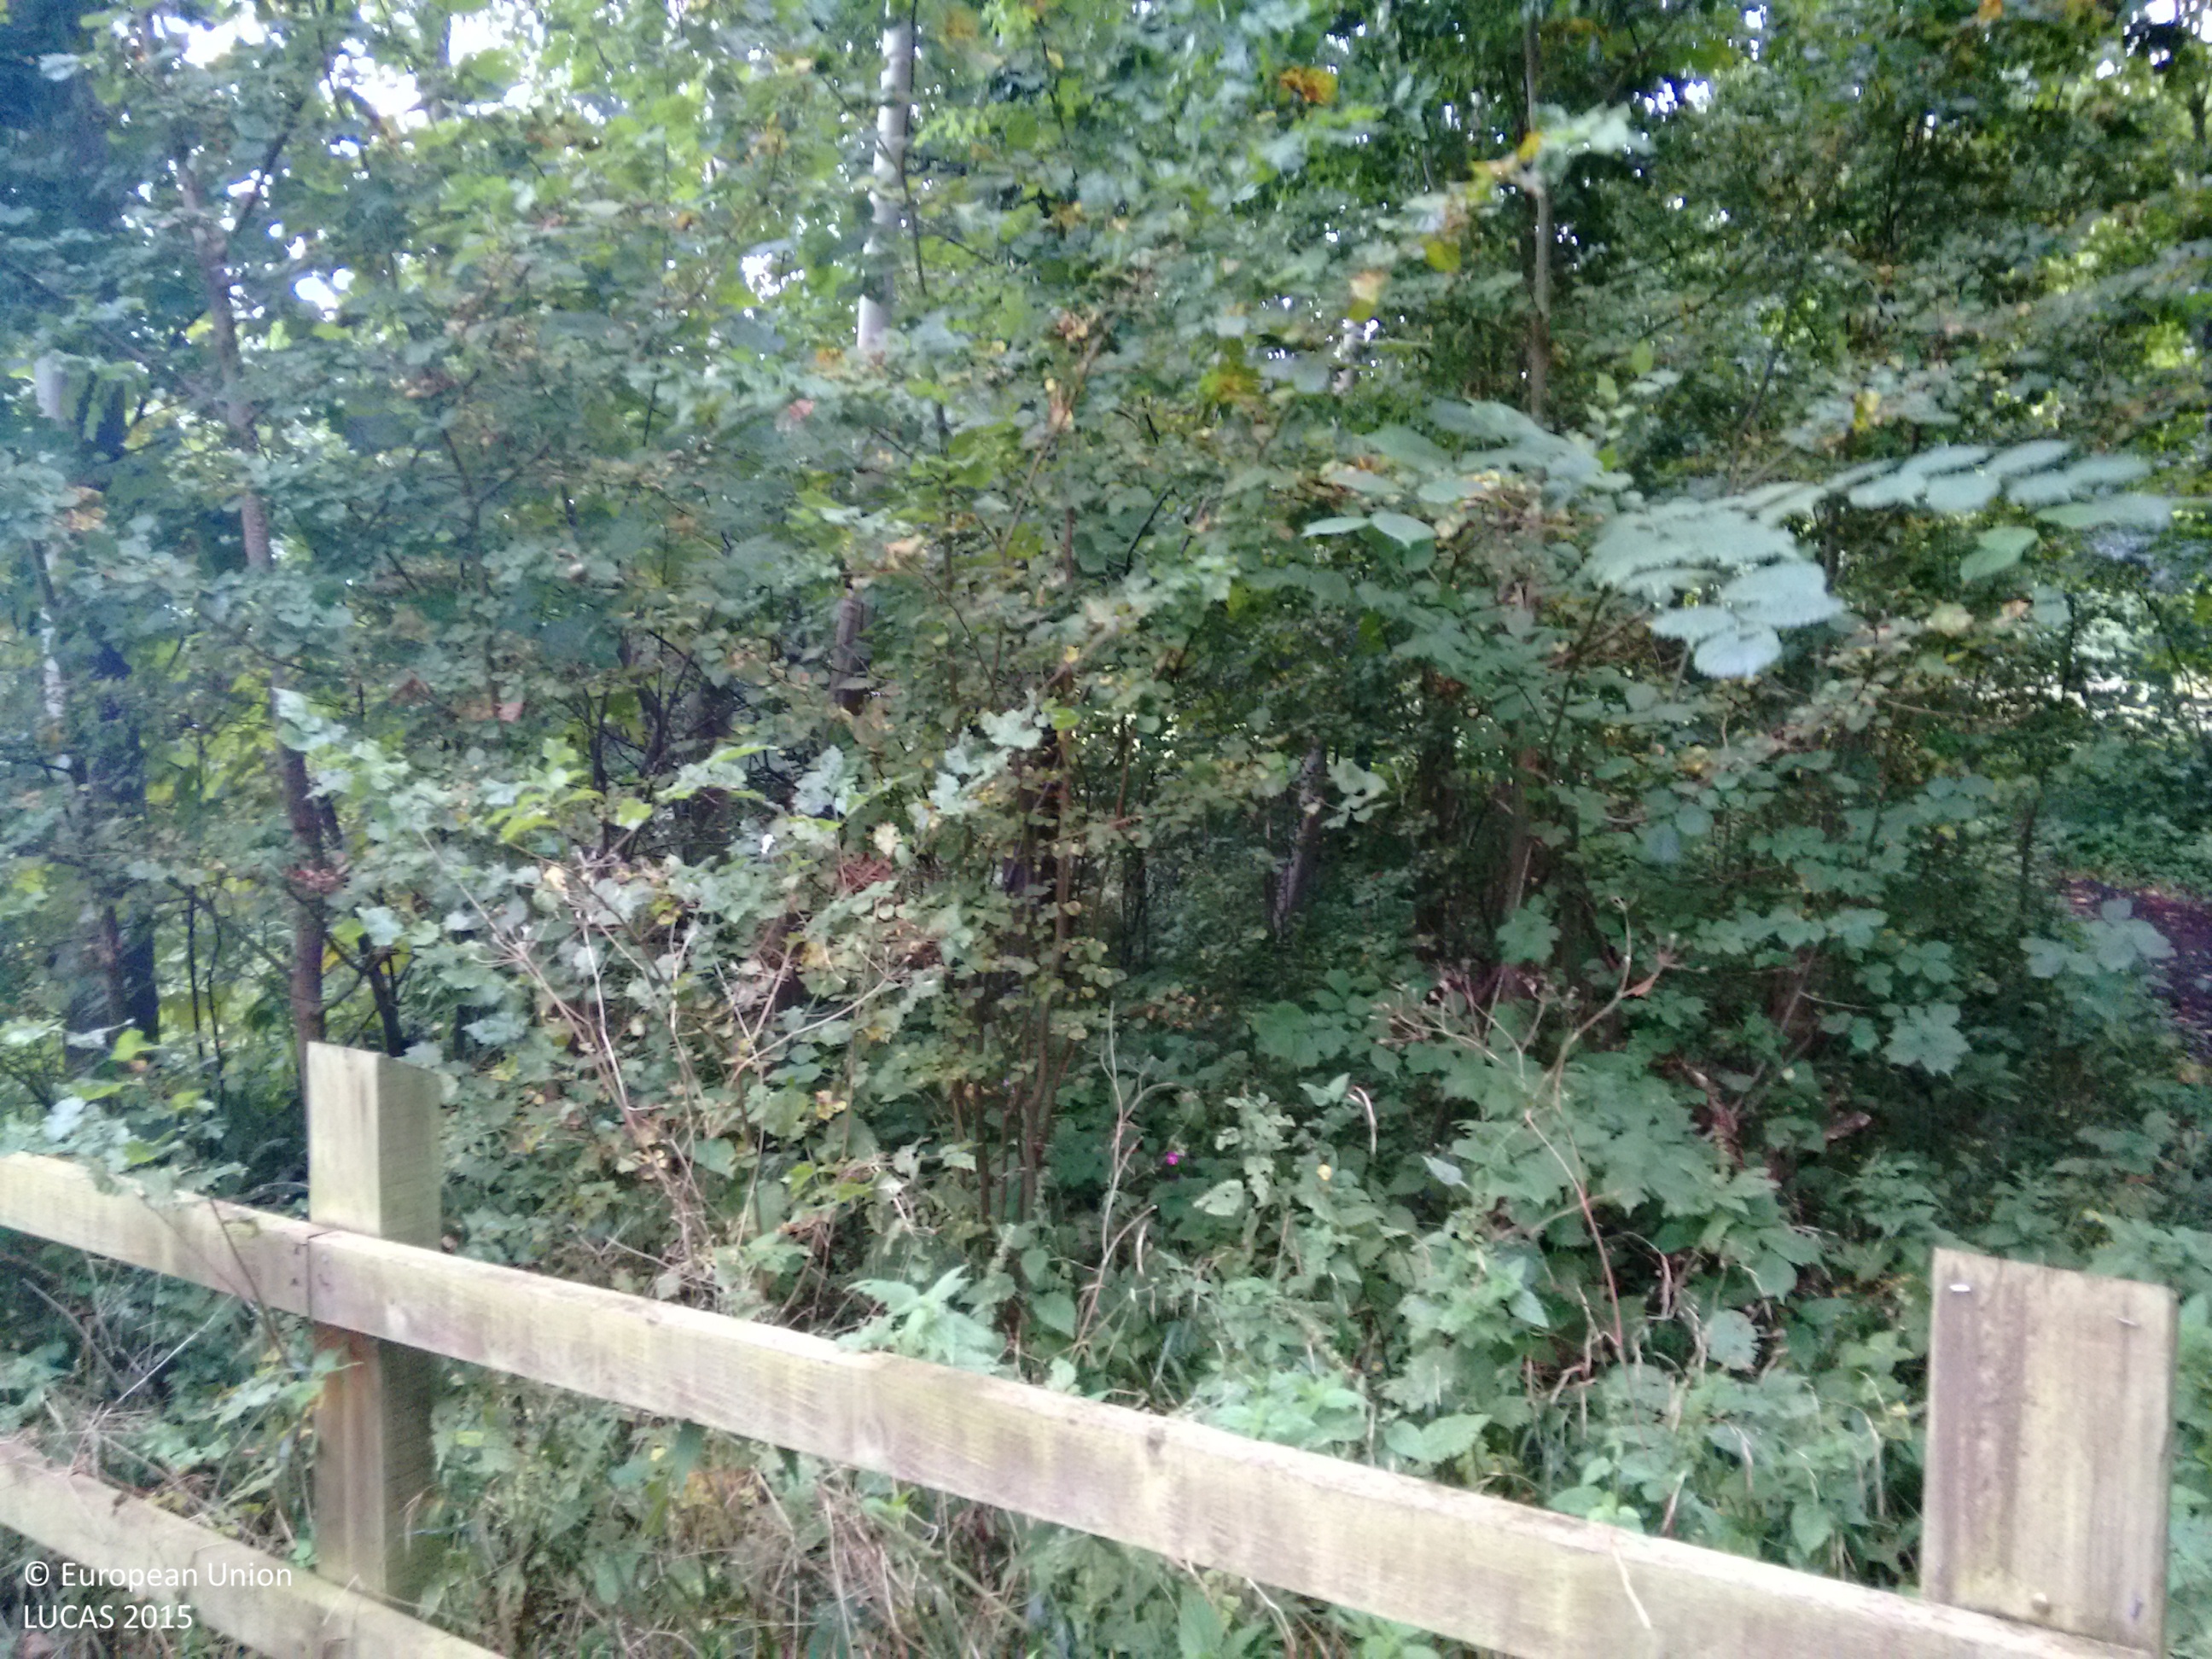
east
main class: Woodland
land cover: Broadleaved woodland
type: mesophytic deciduous forest
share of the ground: > 75 %
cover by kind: broadleaved forest trees 100 %
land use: Amenities, museums, leisure
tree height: > 5 m
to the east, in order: Broadleaved woodland; Grassland without tree/shrub cover; Other mixed woodland; Grass margins; Paved roads, cycling and walking lanes; Shrubland without tree cover; Ditches and canals; Shrubland without tree cover; Grass margins; Tracks; Shrubland without tree cover; Grassland without tree/shrub cover
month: September
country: GB
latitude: 52.6210
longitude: 1.3385
